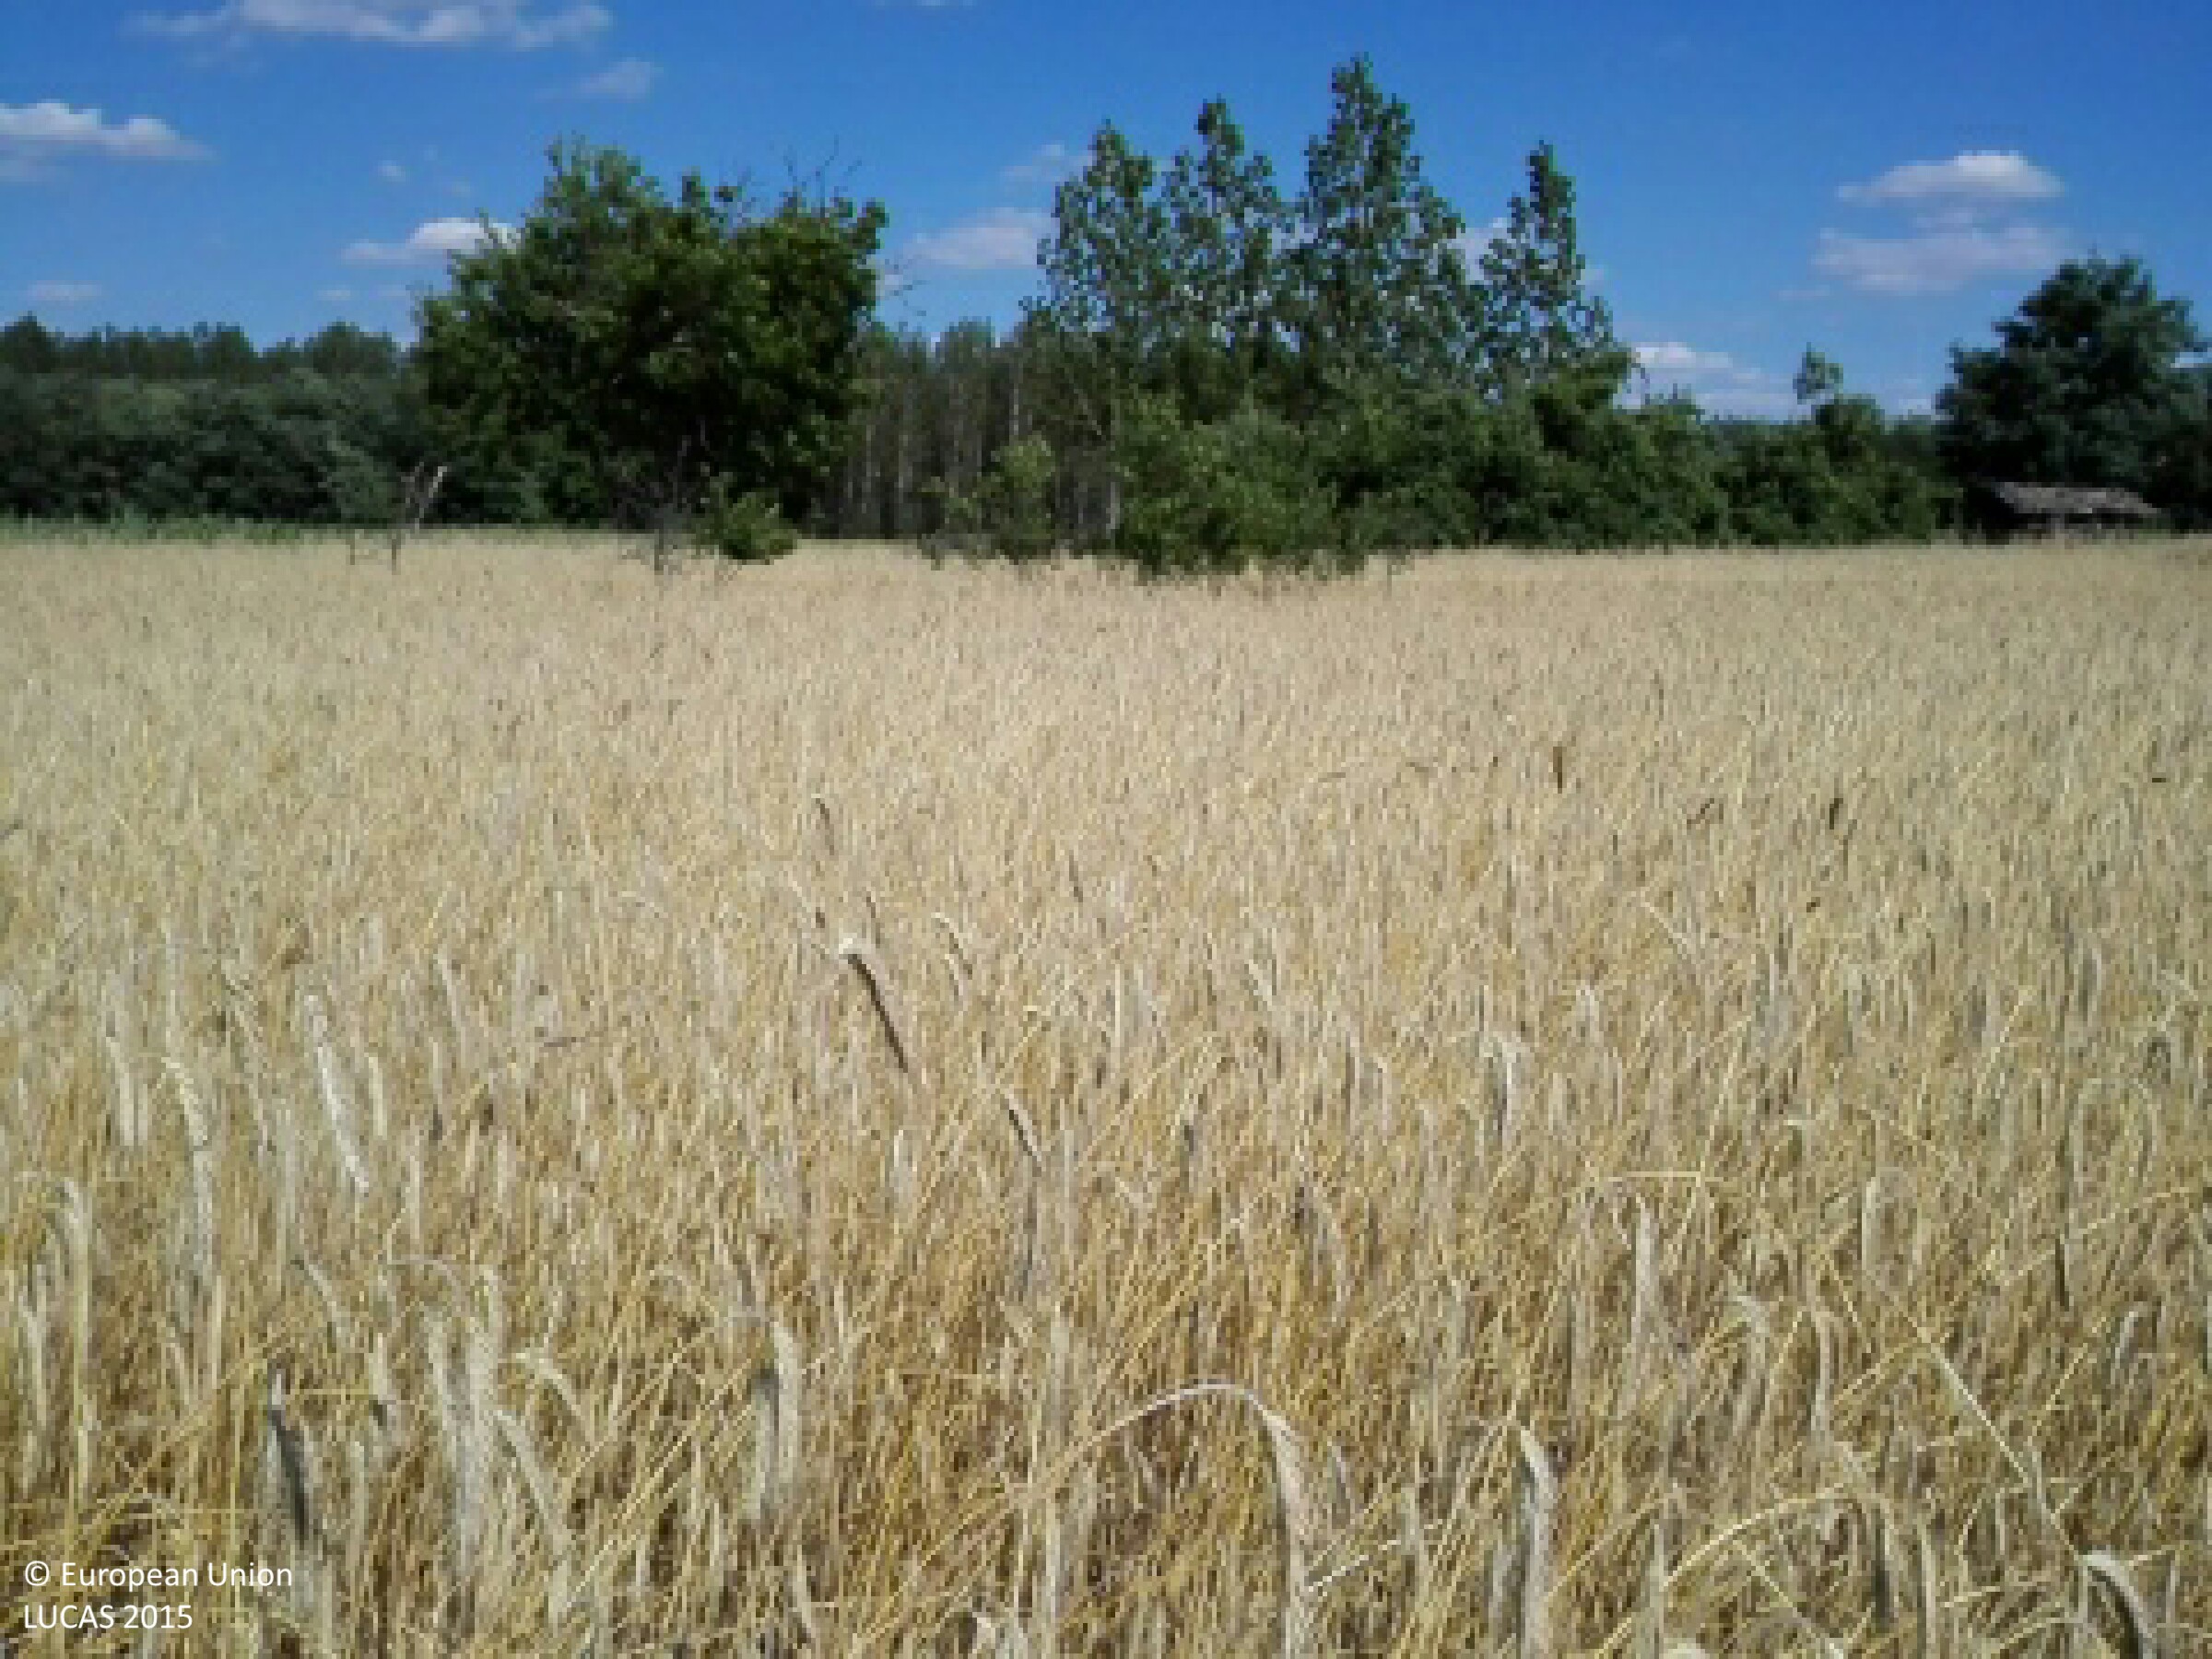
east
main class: Cropland
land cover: Rye
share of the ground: > 75 %
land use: Agriculture (excluding fallow land and kitchen gardens)
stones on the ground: < 10 %
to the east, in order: Rye; Grassland with sparse tree/shrub cover; Rye; Grassland with sparse tree/shrub cover; Other fresh vegetables; Maize; Grassland without tree/shrub cover; Broadleaved woodland
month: July
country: HU
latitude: 47.6594
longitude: 21.8052
